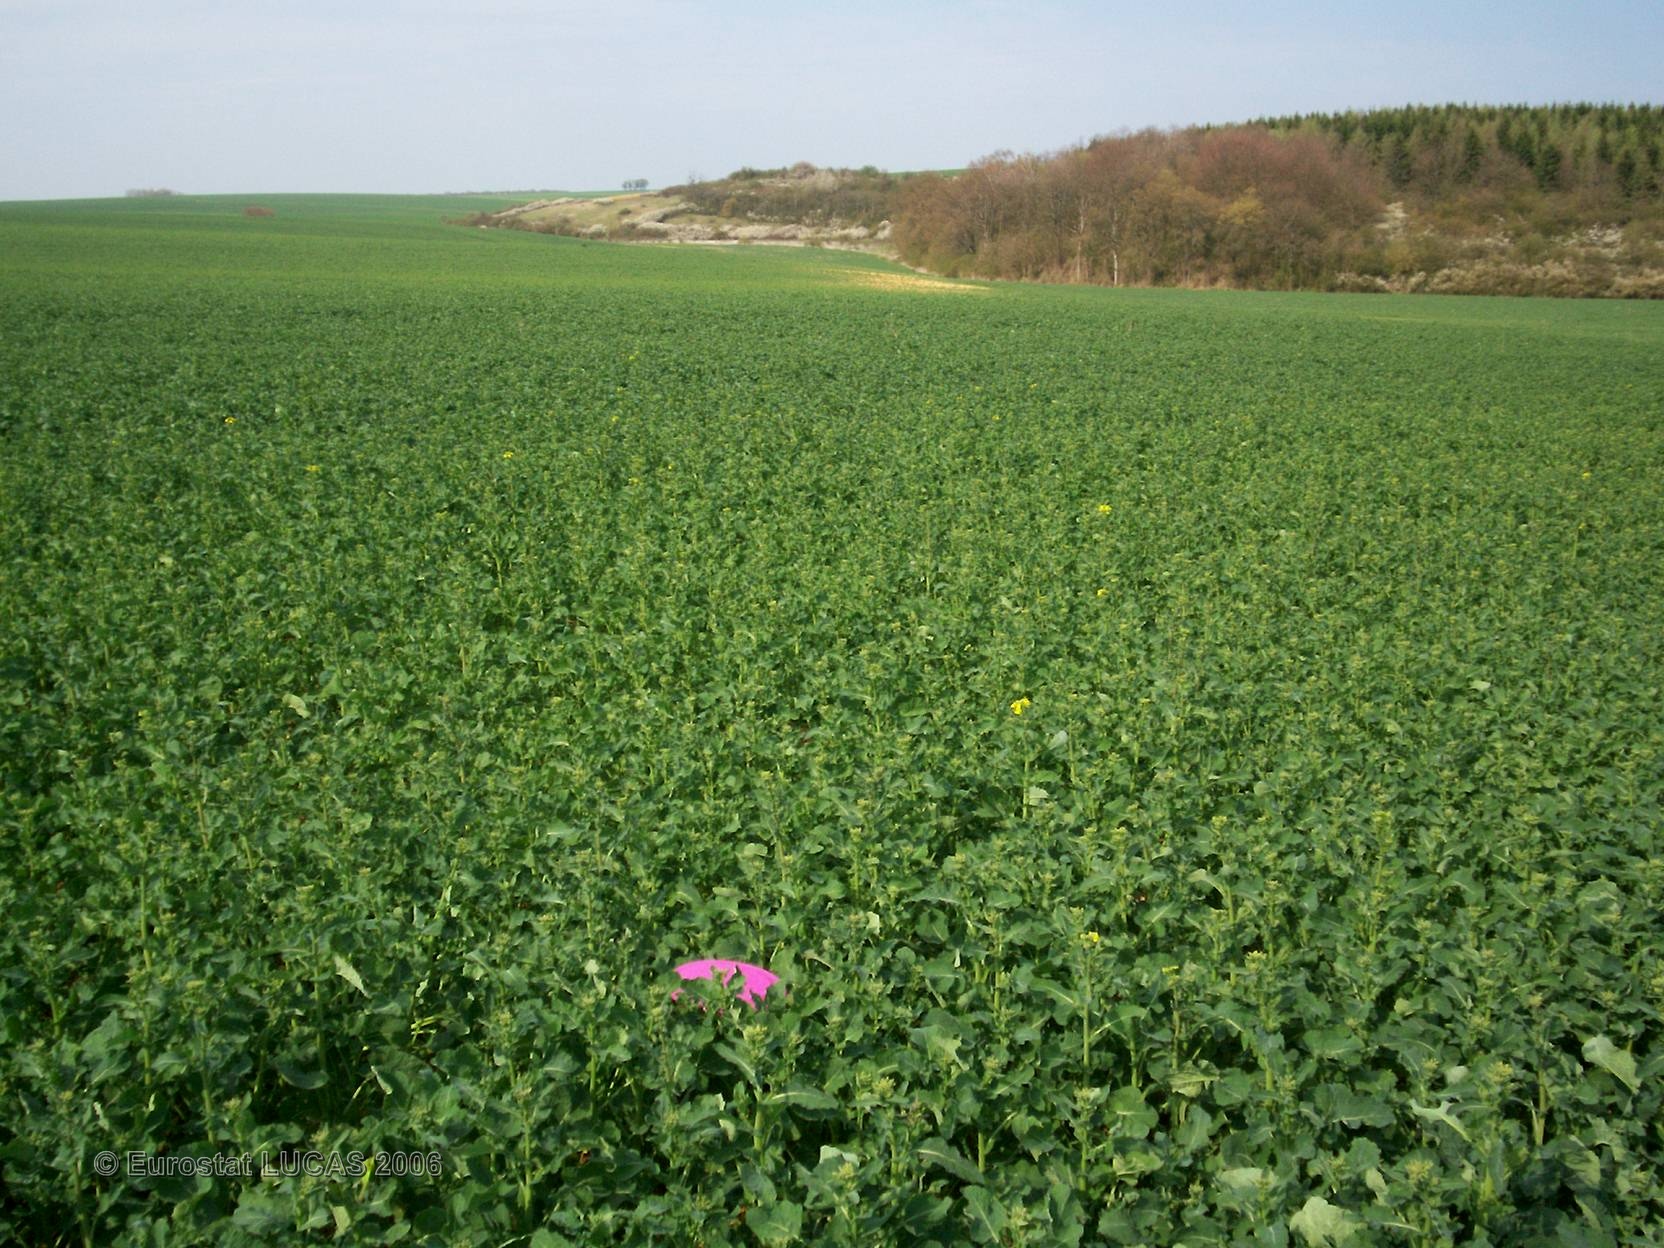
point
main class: Cropland
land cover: Rape and turnip rape
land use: Agriculture (excluding fallow land and kitchen gardens)
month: April
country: FR
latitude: 49.0673
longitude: 5.9343
